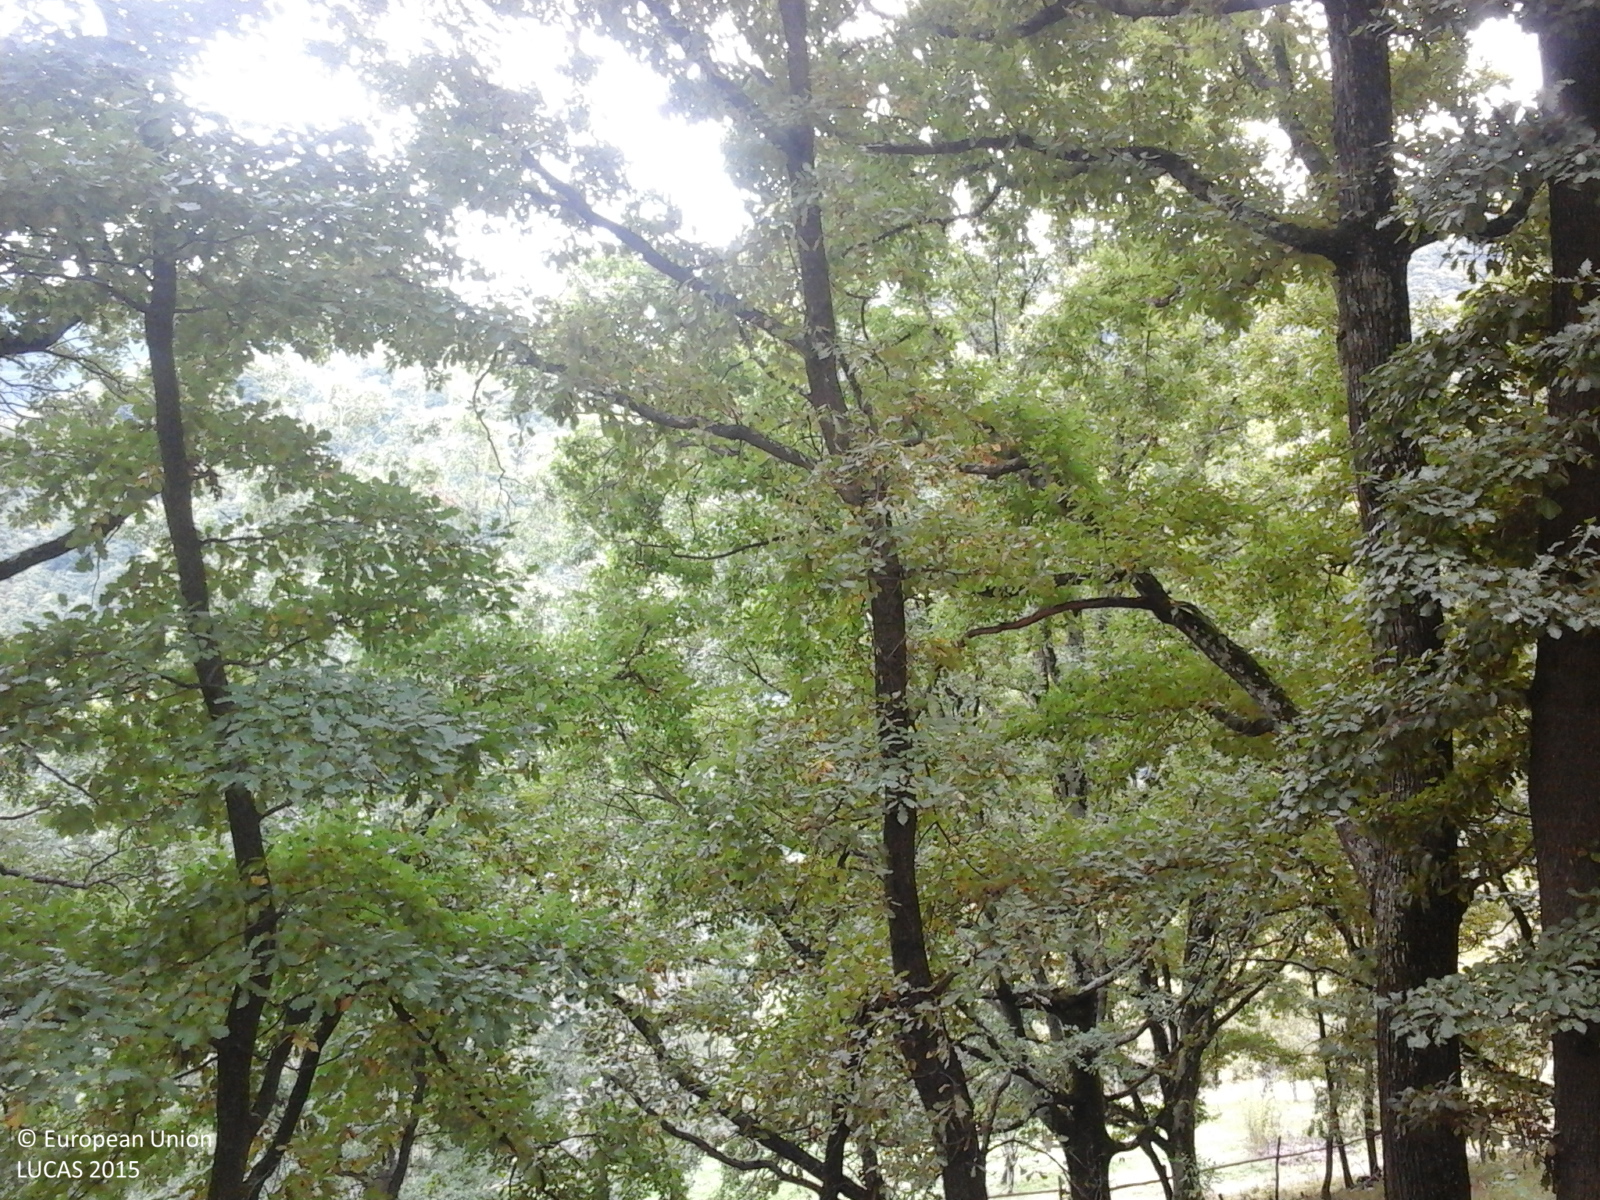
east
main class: Woodland
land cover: Broadleaved woodland
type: acidophilous oak and oak-birch forest
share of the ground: > 75 %
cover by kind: broadleaved forest trees 100 %
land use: Forestry
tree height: > 5 m
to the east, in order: Broadleaved woodland; Ditches and canals; Paved roads, cycling and walking lanes; Broadleaved woodland; Grassland without tree/shrub cover; Fences; Other fruit trees and berries; Electric lines; Other fruit trees and berries; Fences; Shruby margins; Tracks; Shruby margins; Fences; Other fruit trees and berries; Fences; Grassland without tree/shrub cover; Electric lines; Grassland without tree/shrub cover; Fences; Ditches and canals; Paved roads, cycling and walking lanes
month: September
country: RO
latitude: 45.7659
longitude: 23.6307
